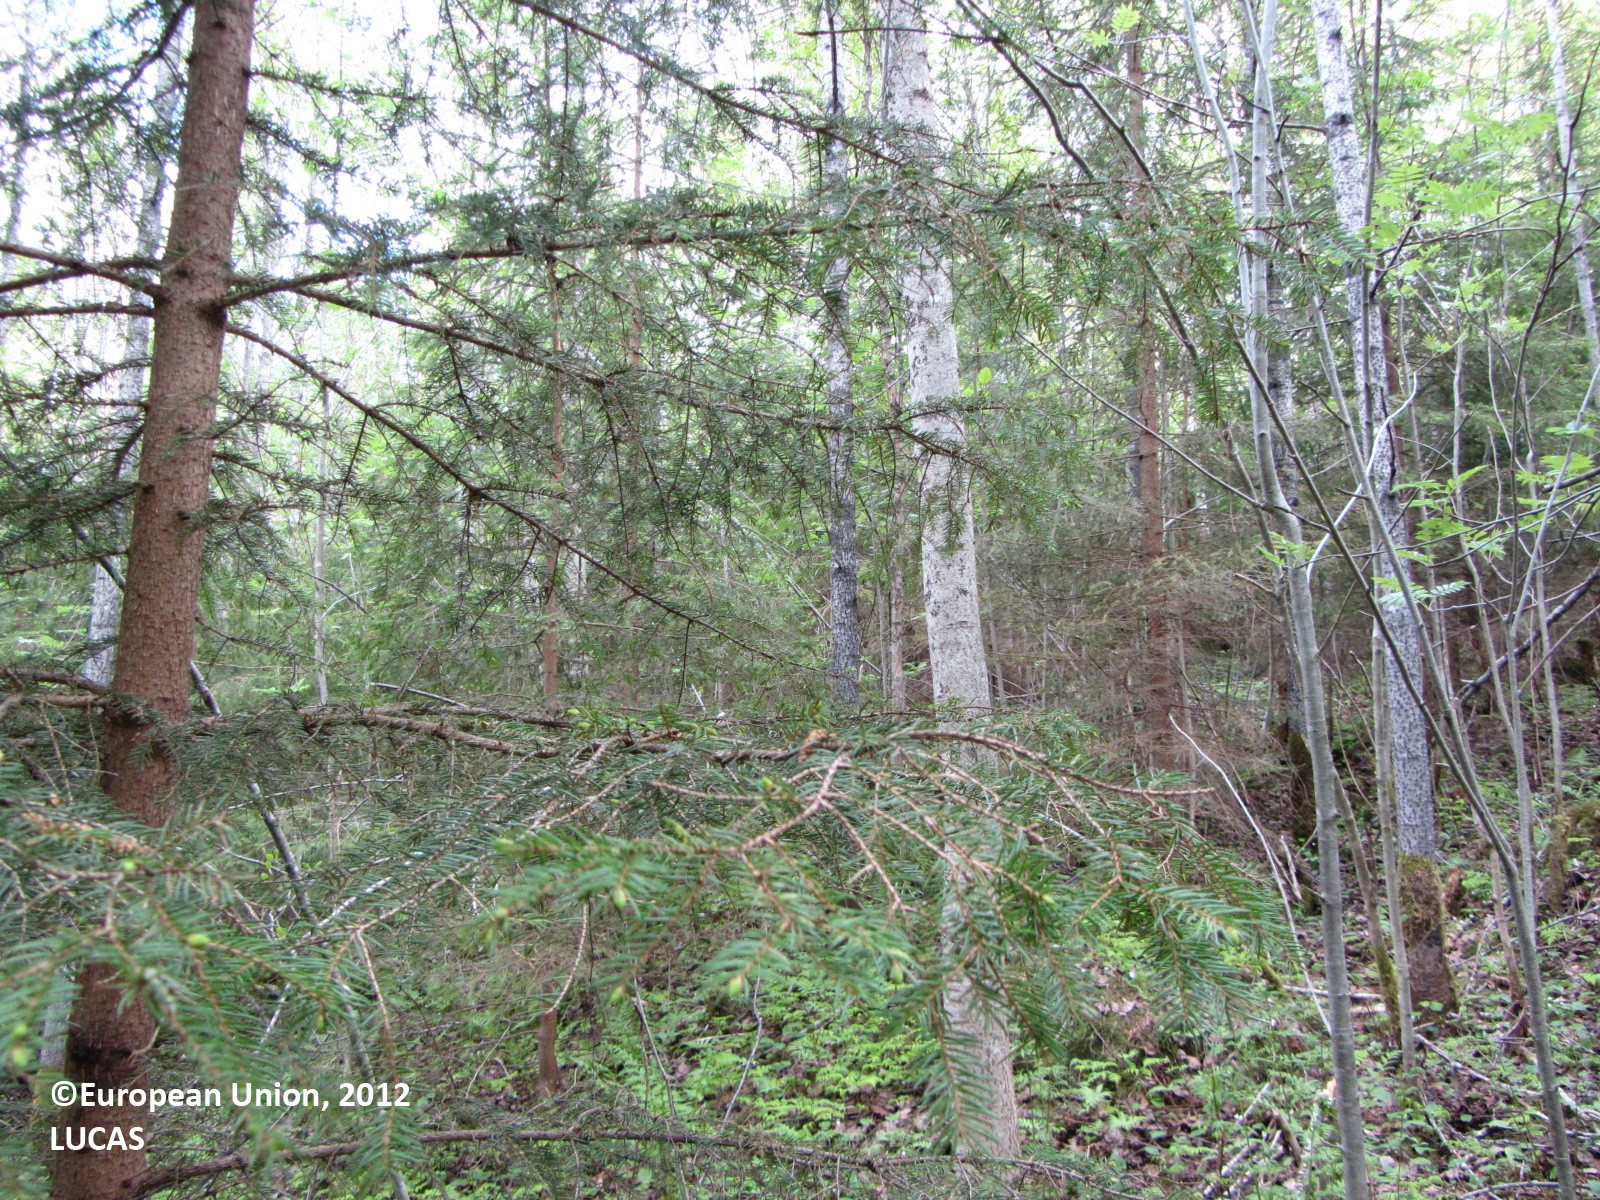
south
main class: Woodland
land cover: Spruce dominated mixed woodland
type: boreal forest
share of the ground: > 75 %
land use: Forestry
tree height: > 5 m
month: May
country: FI
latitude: 62.2788
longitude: 25.3530
